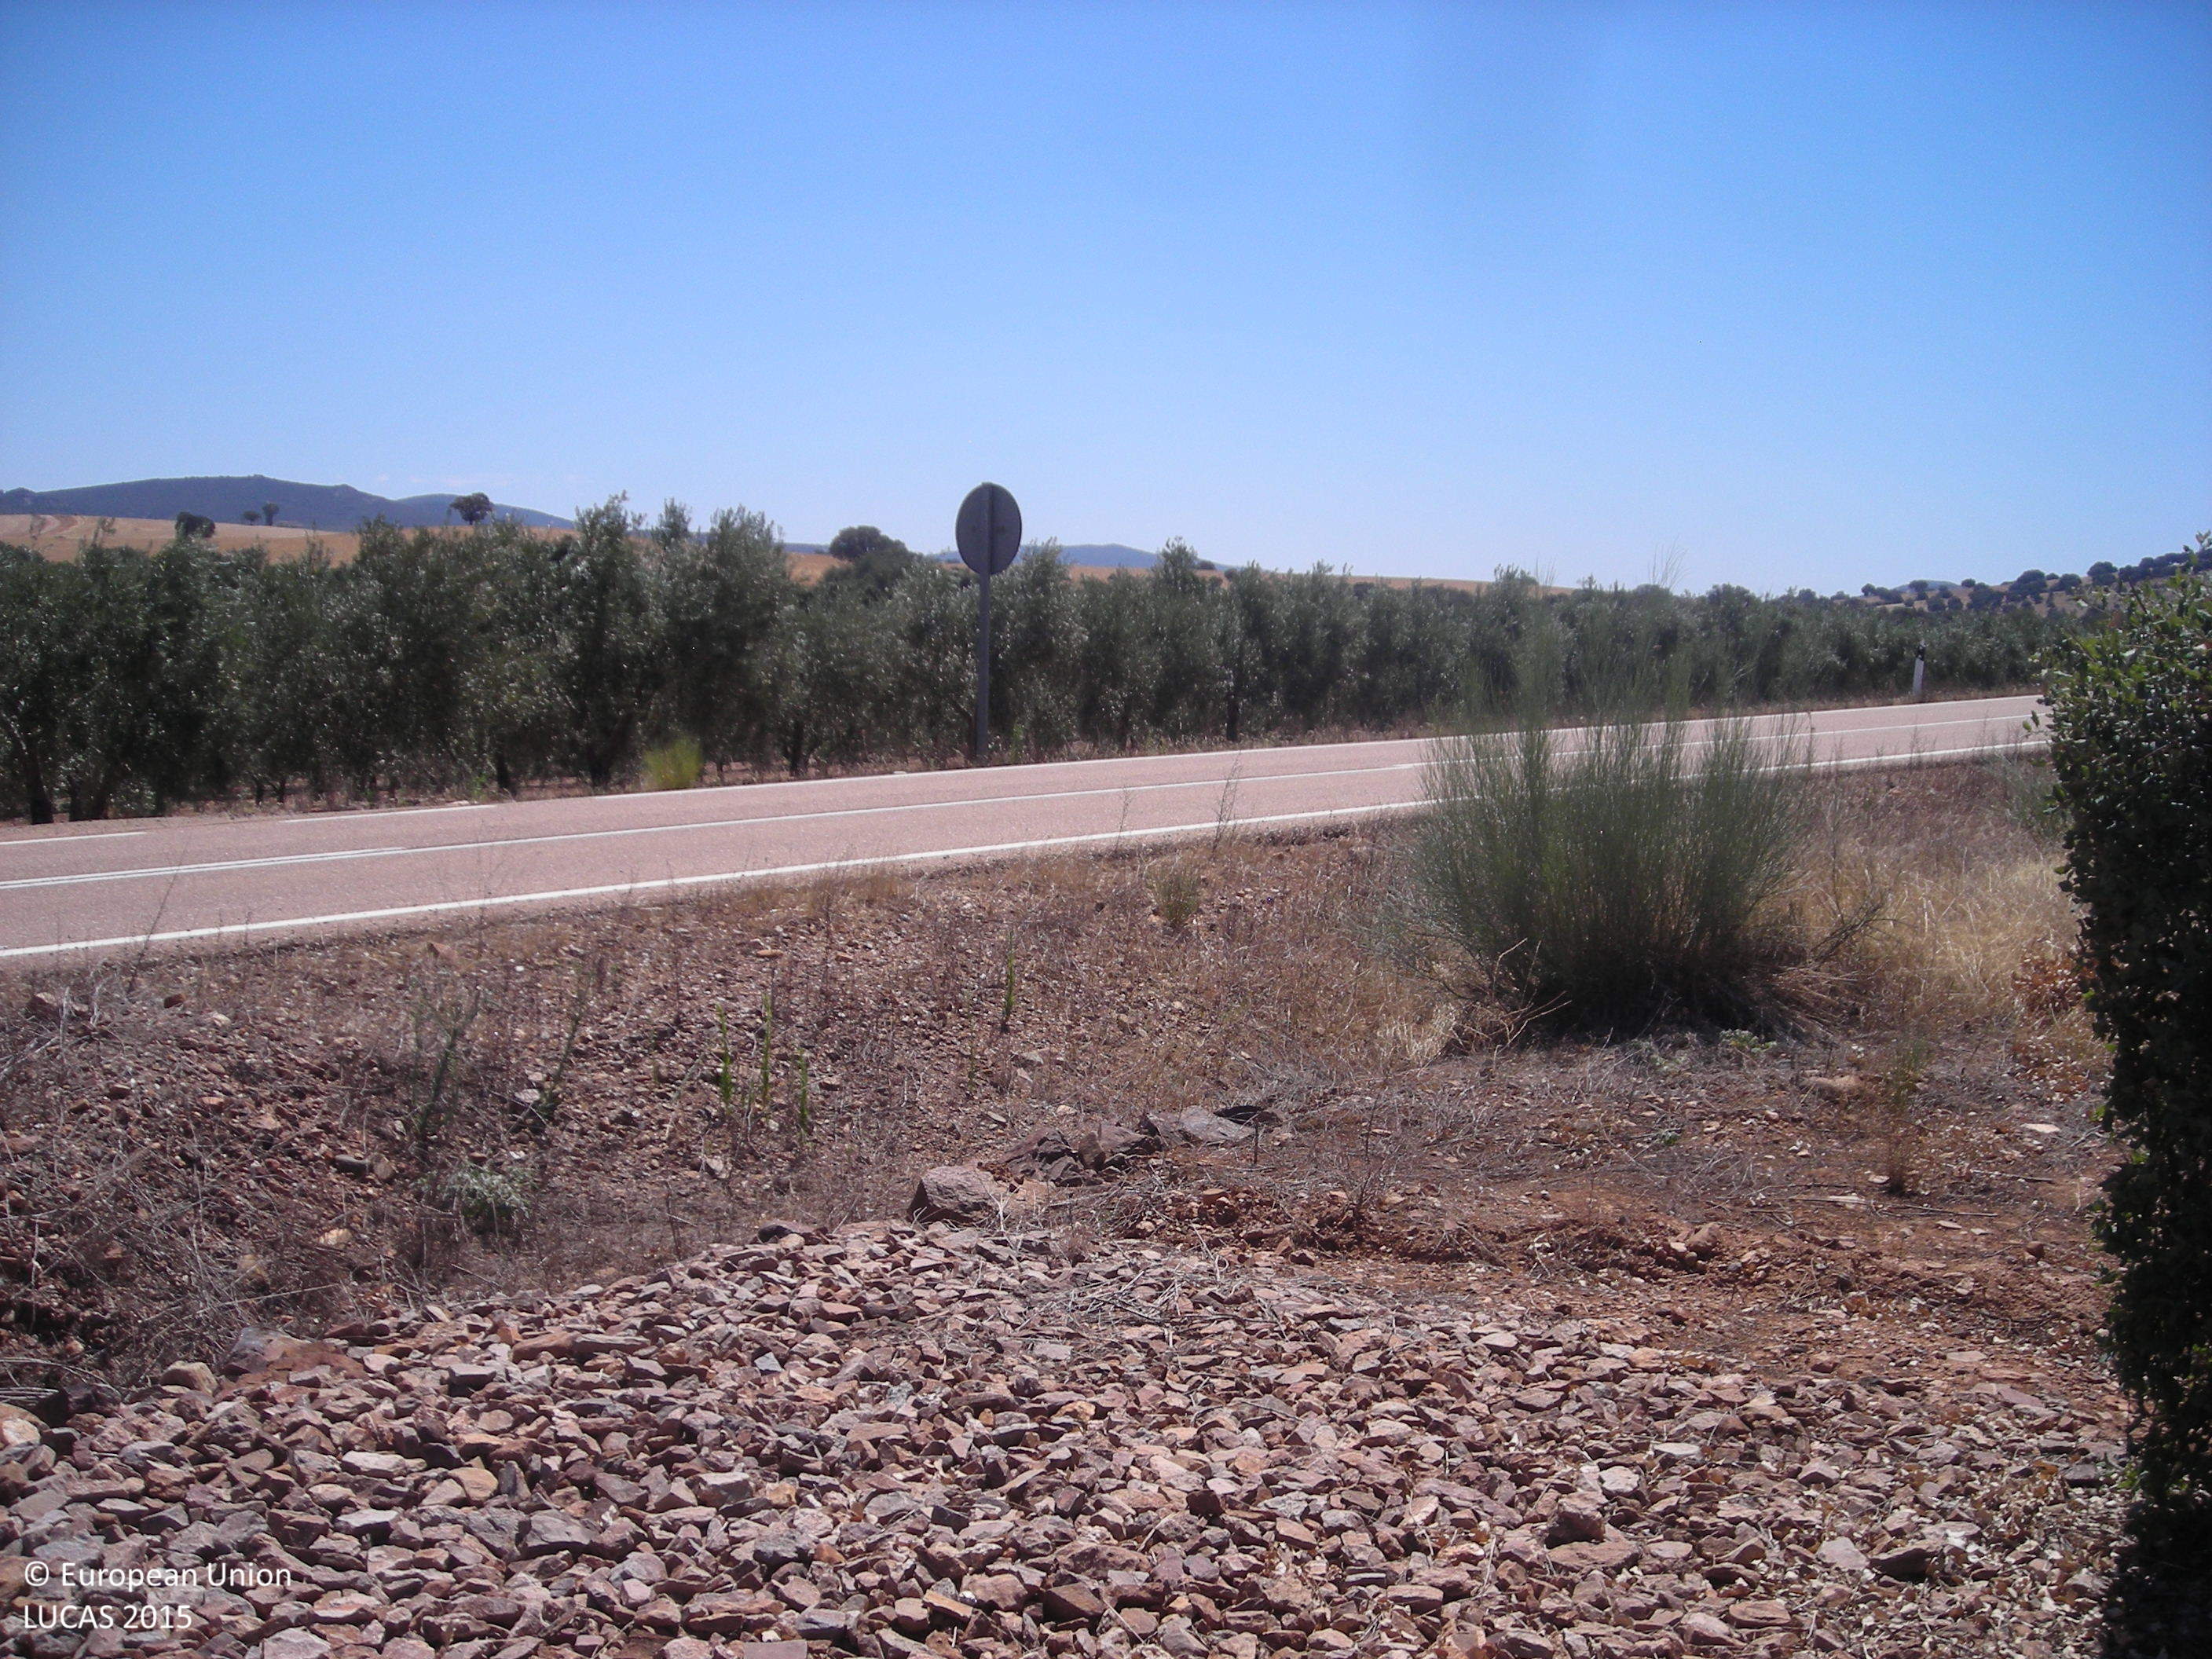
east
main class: Woodland
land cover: Broadleaved woodland
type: broadleaved evergreen forest
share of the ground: 25 - 50 %
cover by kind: broadleaved forest trees 40 %, shrubs 30 %, herbaceous plants 30 %
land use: Forestry
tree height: > 5 m
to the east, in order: Broadleaved woodland; Arable land (only in case pi); Single bushes/trees; Arable land (only in case pi)
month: July
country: ES
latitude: 38.7638
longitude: -5.8704
